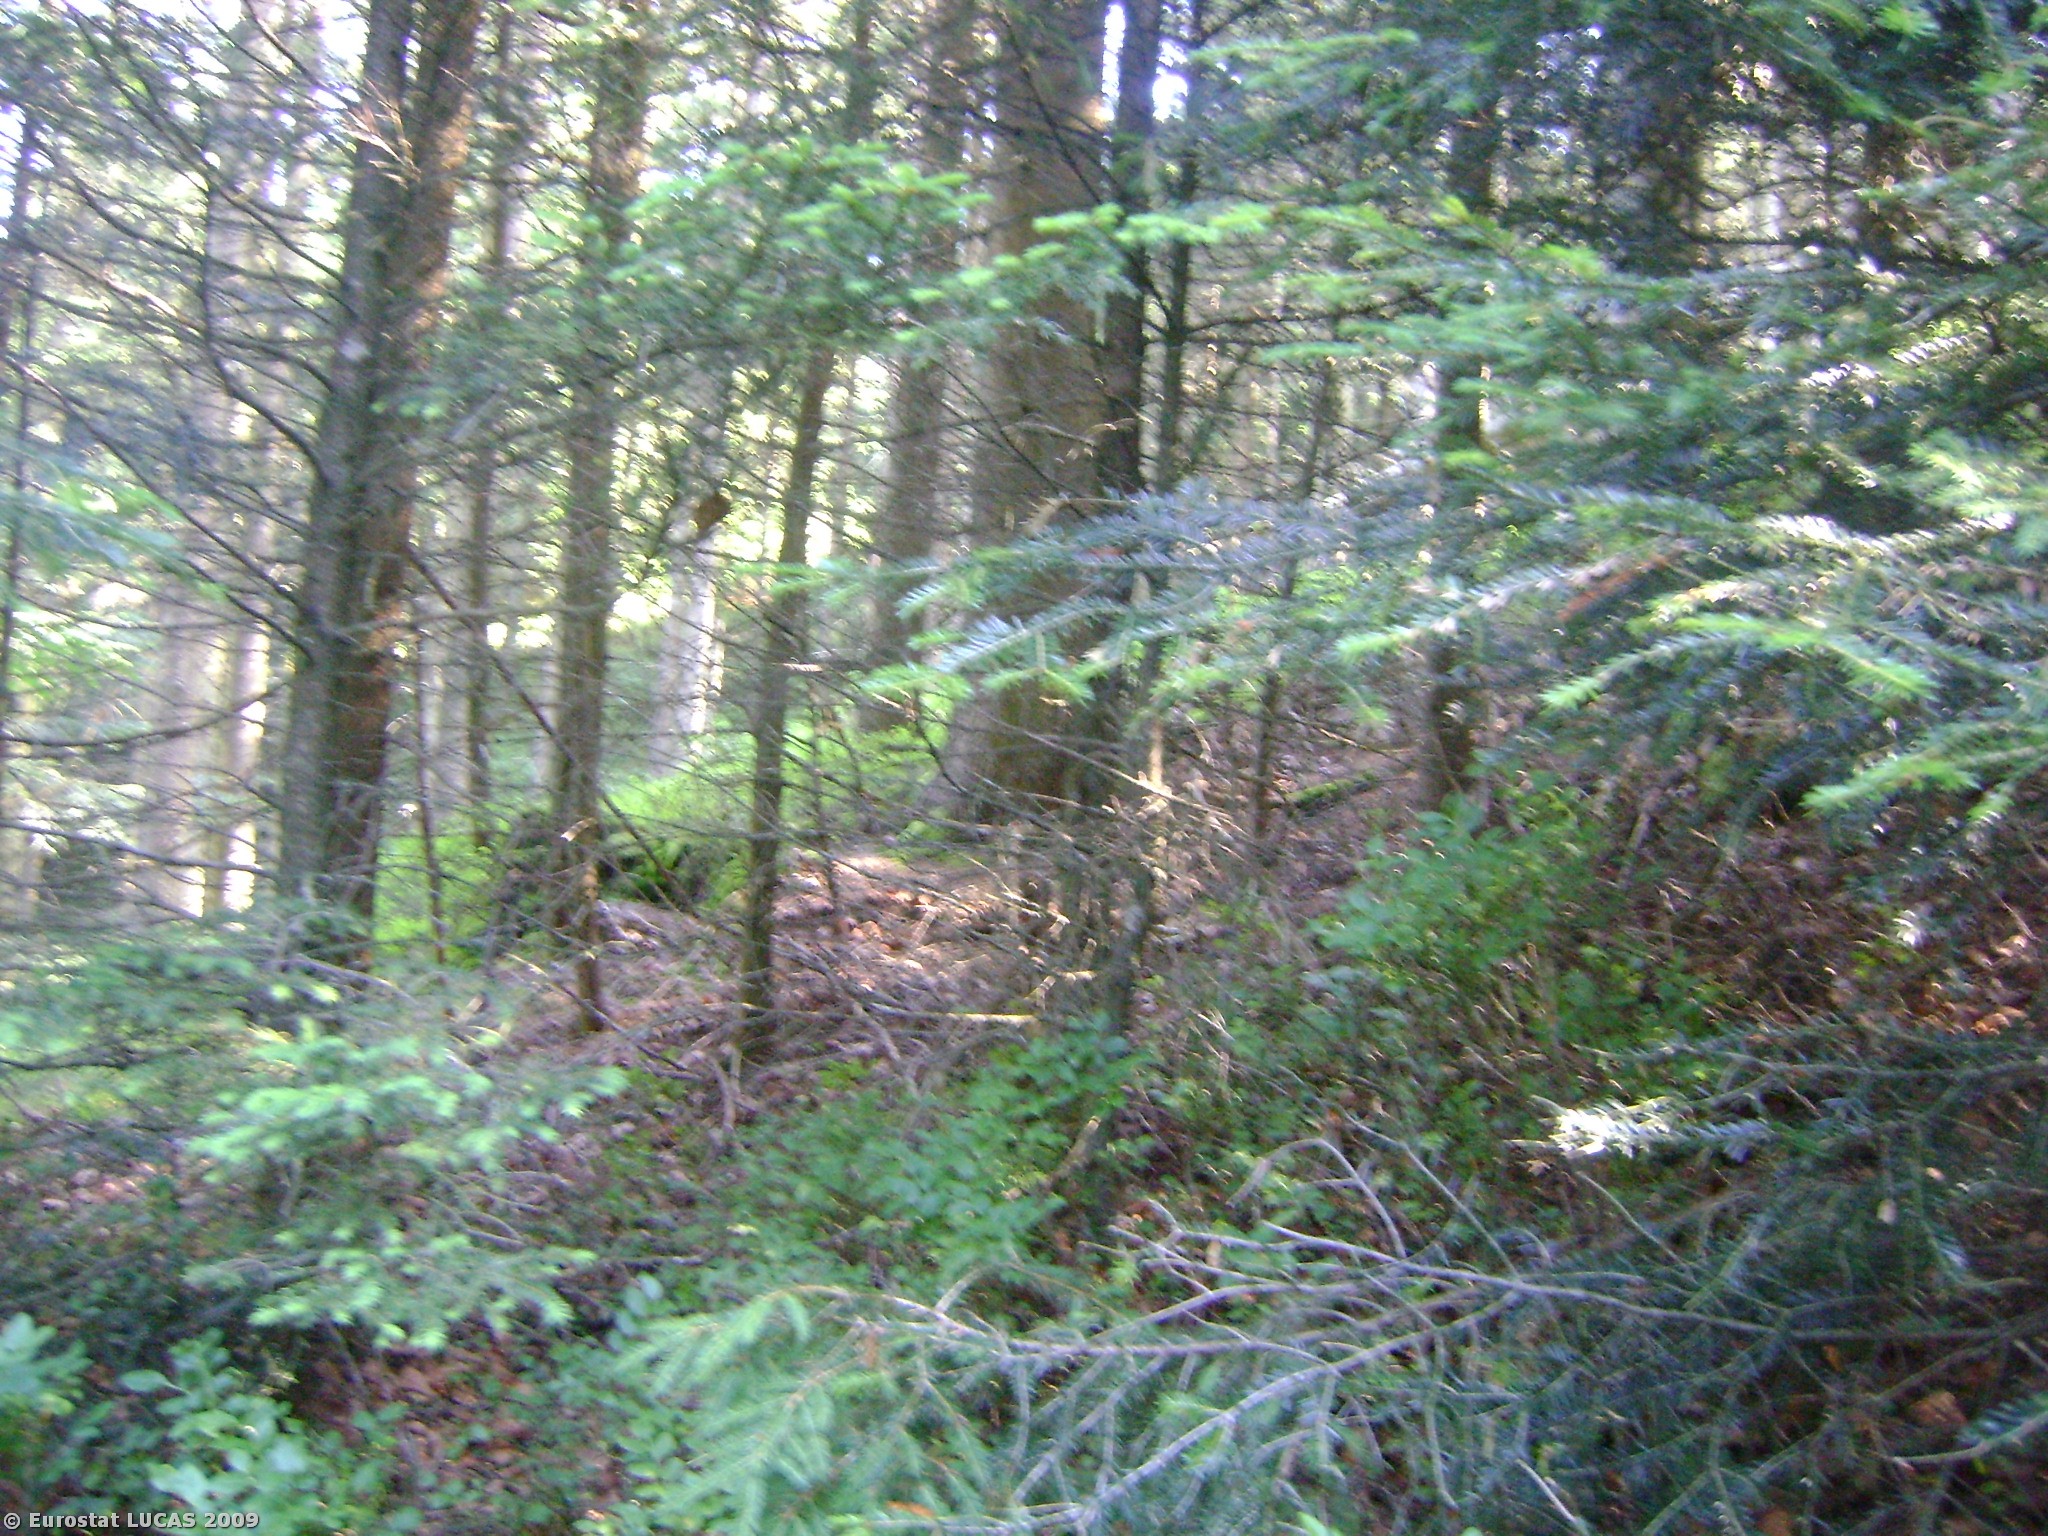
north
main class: Woodland
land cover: Coniferous woodland
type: hemiboreal forest and nemoral coniferous forest and mixed broadleaved-coniferous forest
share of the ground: > 75 %
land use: Forestry
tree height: > 5 m
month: June
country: AT
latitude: 48.0314
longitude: 13.2577
